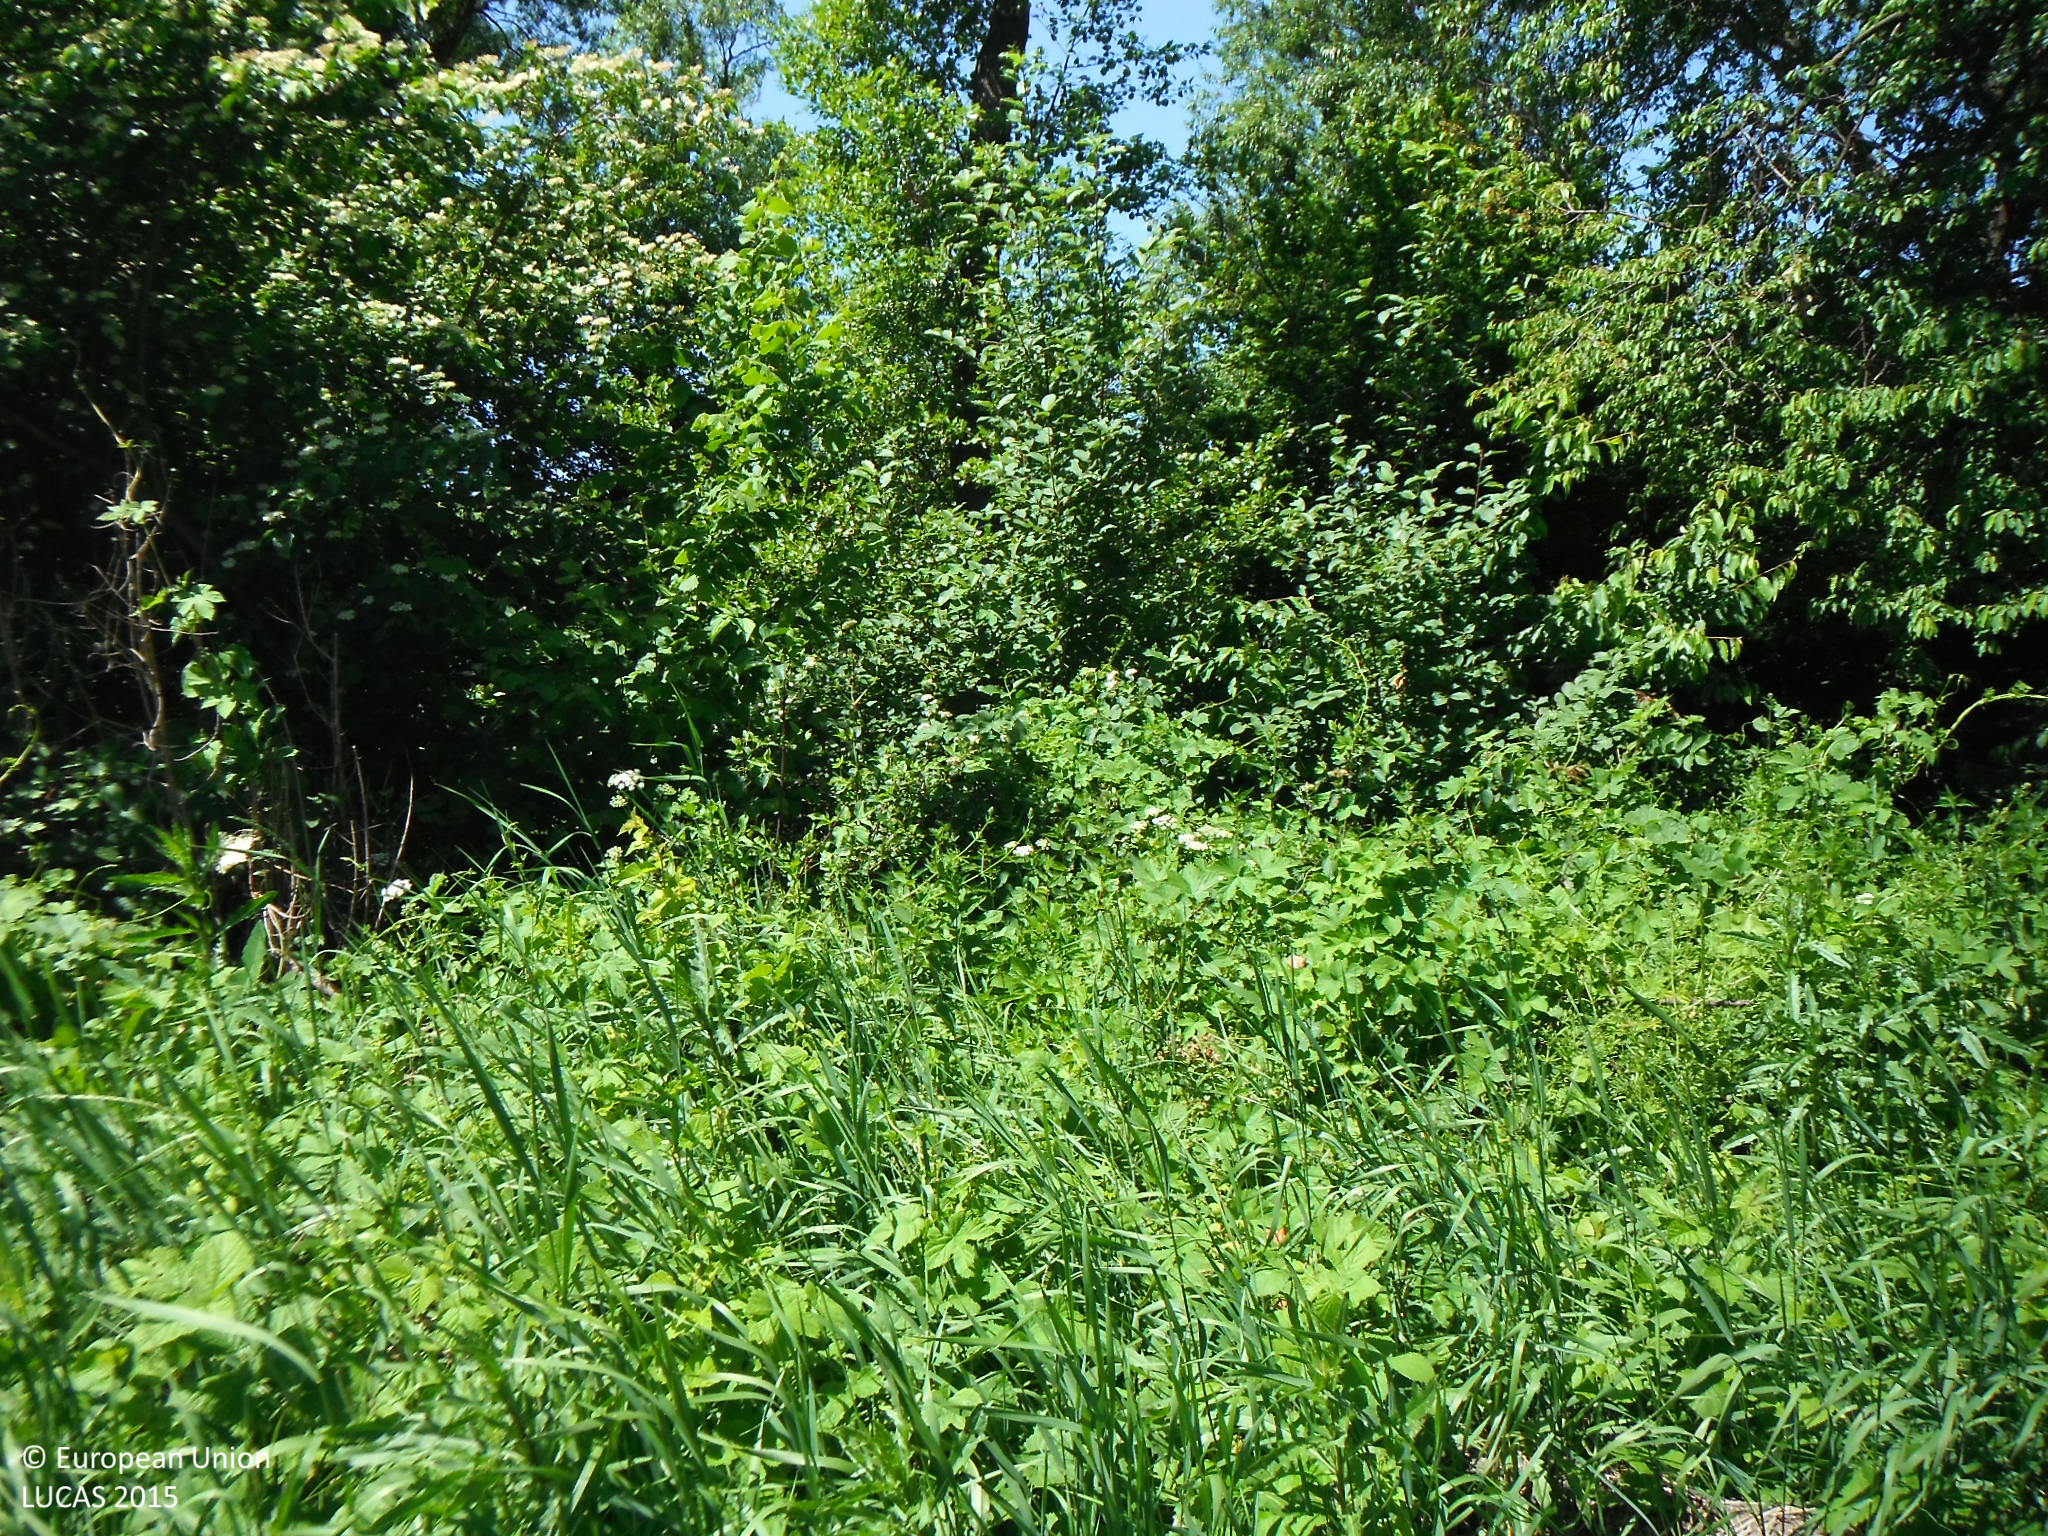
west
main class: Grassland
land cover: Spontaneously vegetated surfaces
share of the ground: > 75 %
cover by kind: herbaceous plants 100 %
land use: Semi-natural and natural areas not in use
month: June
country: SK
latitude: 48.8736
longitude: 21.3213
